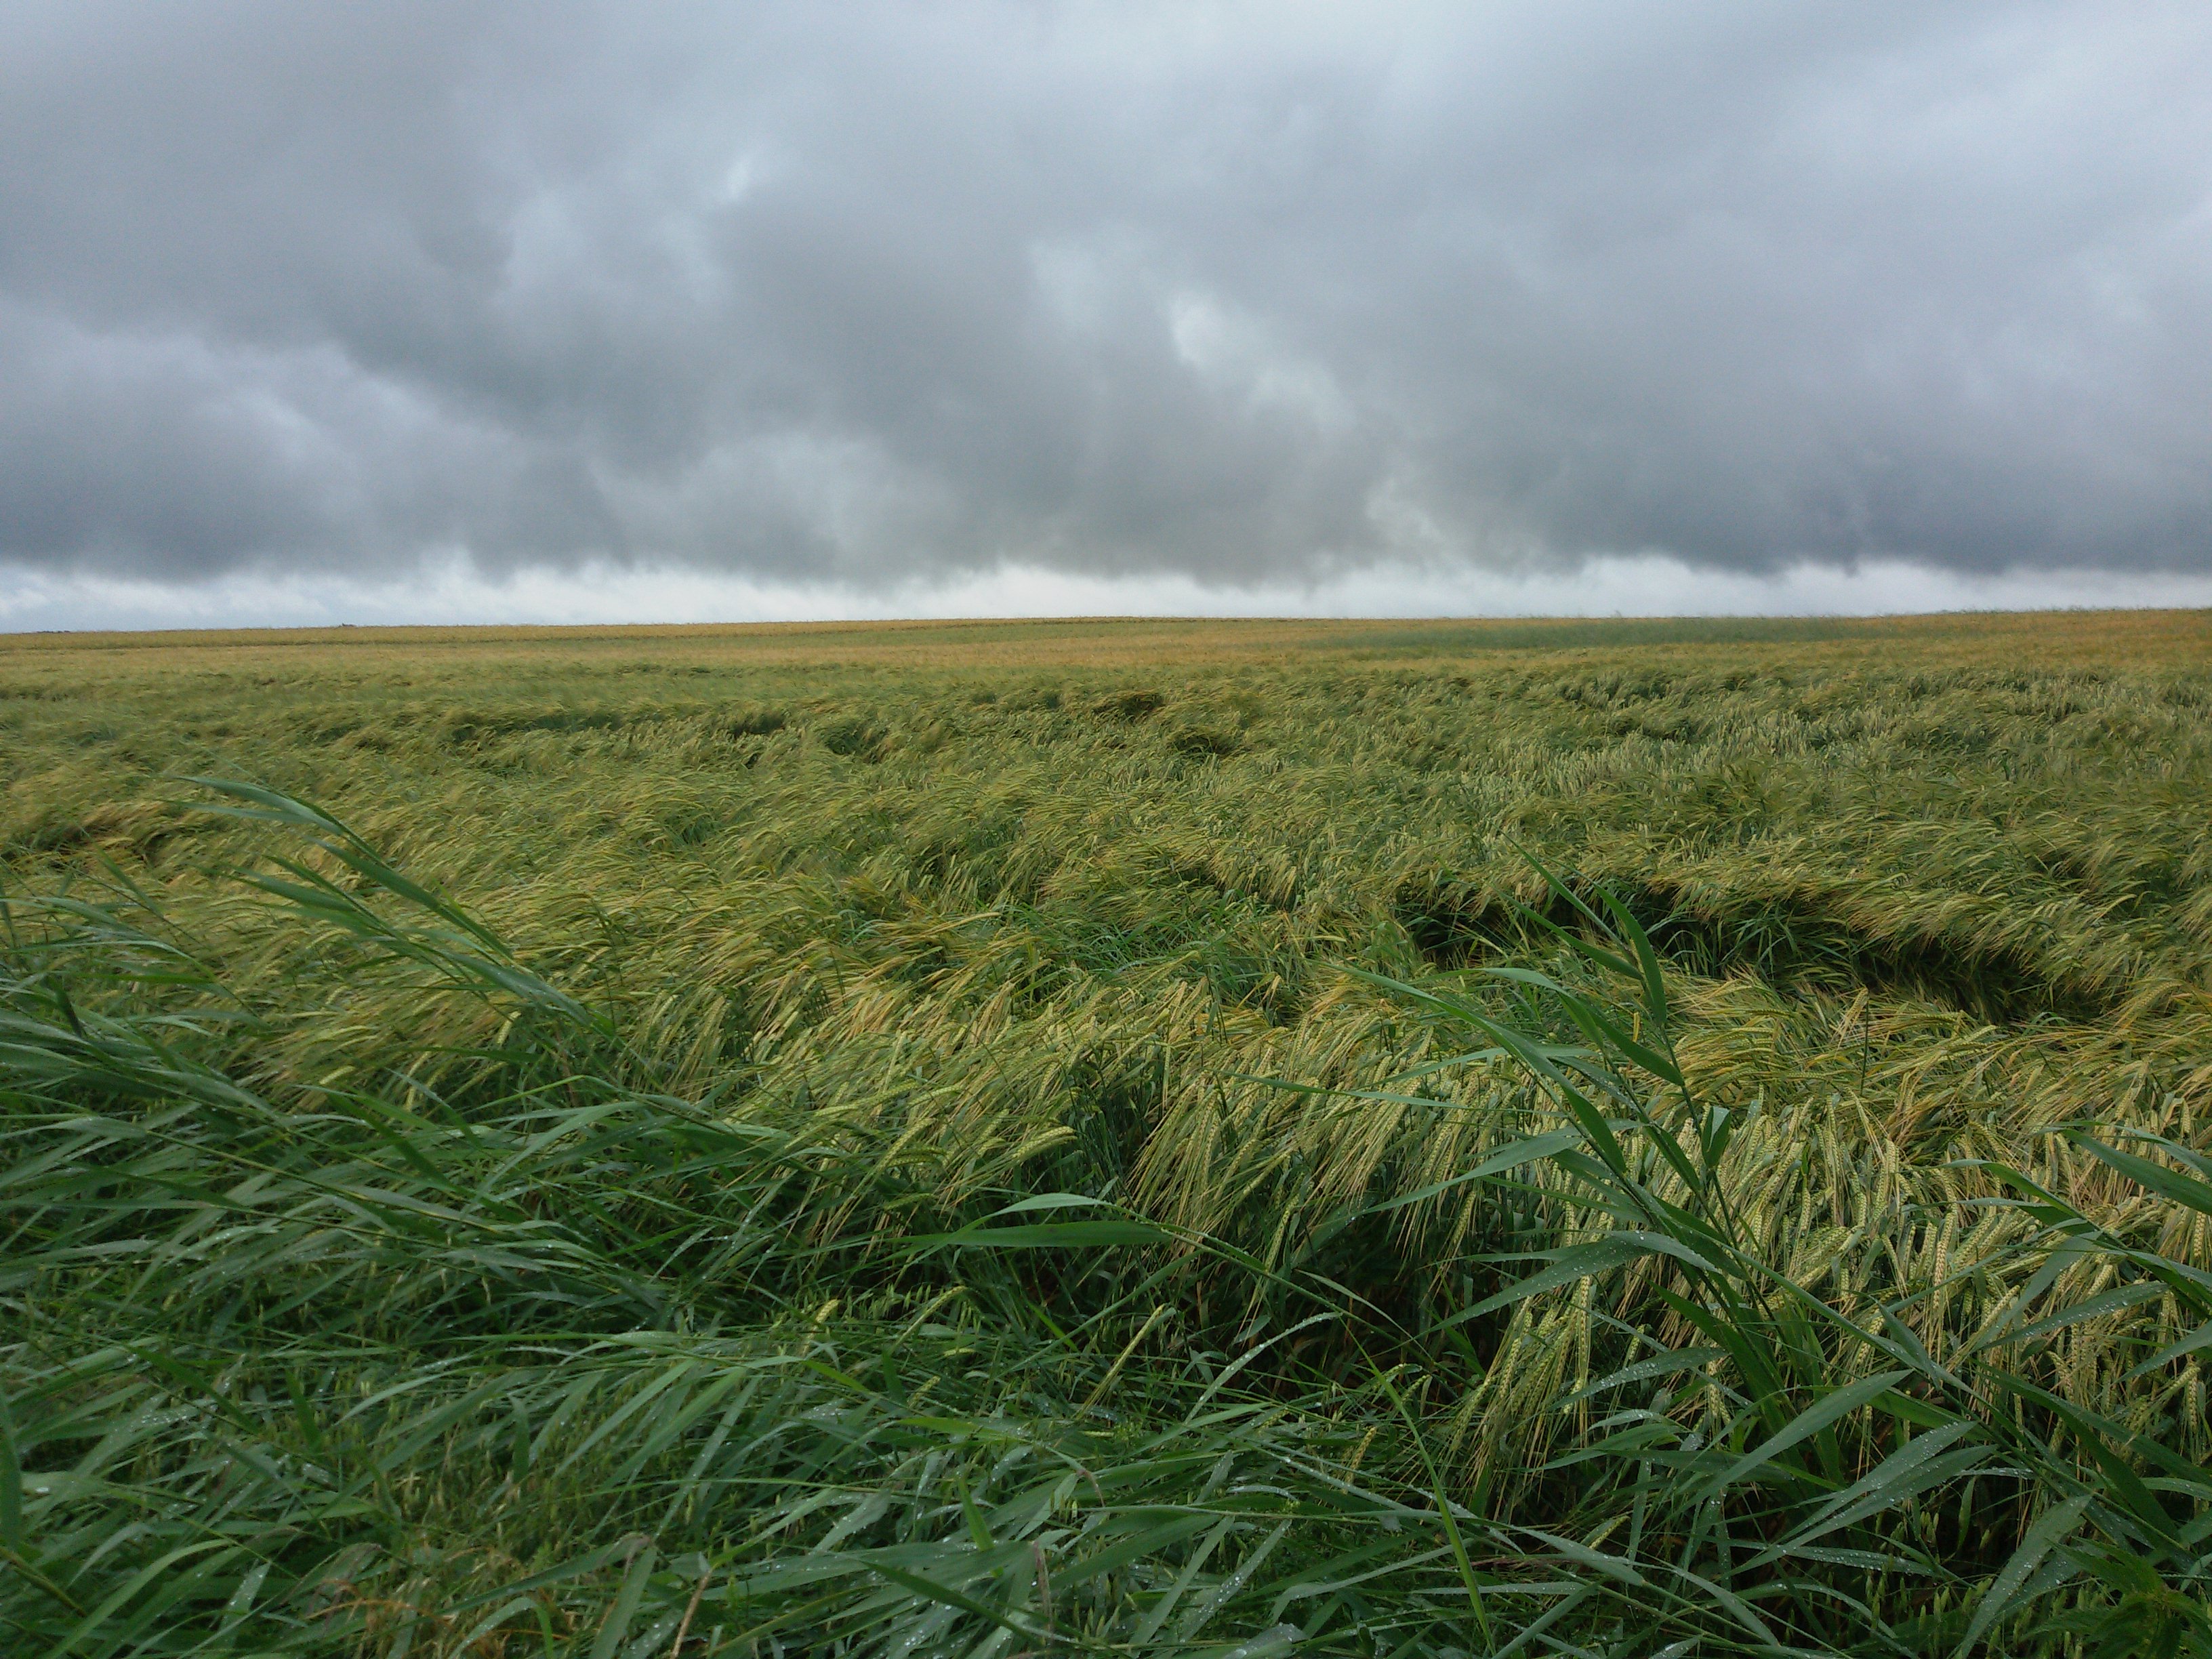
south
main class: Cropland
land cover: Barley
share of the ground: > 75 %
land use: Agriculture (excluding fallow land and kitchen gardens)
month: July
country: PL
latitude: 52.9113
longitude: 17.5816
